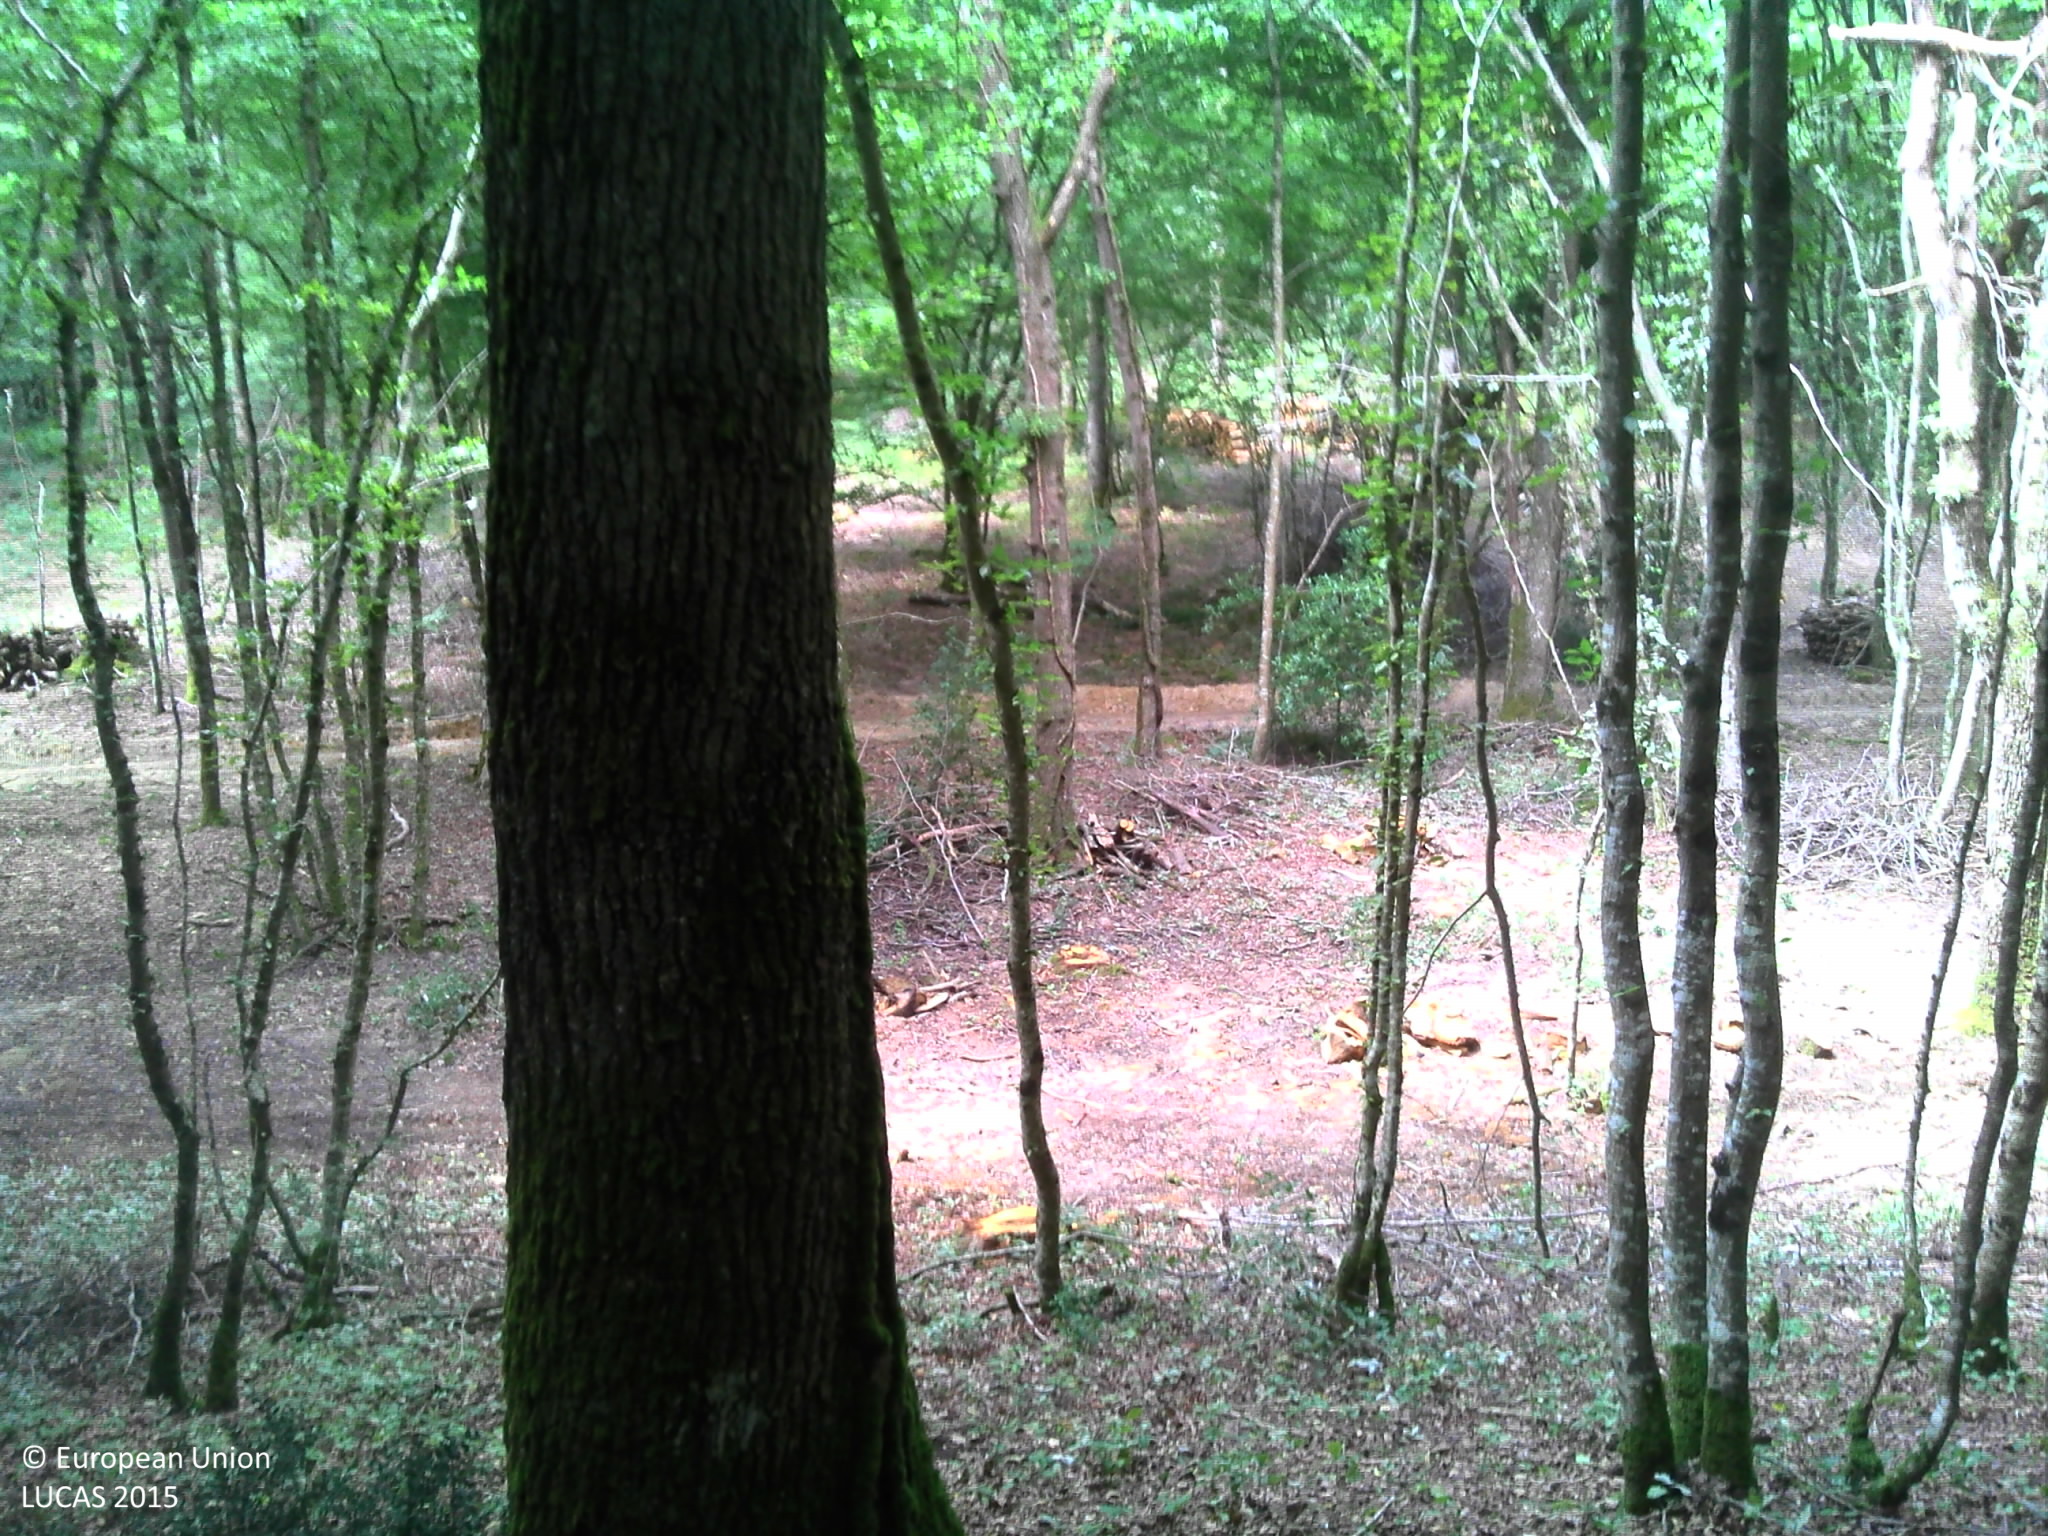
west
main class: Woodland
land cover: Broadleaved woodland
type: mesophytic deciduous forest
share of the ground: > 75 %
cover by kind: broadleaved forest trees 85 %, shrubs 5 %, herbaceous plants 5 %, lichens and mosses 5 %
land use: Forestry
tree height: > 5 m
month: July
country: FR
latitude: 46.8970
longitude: 0.8083
